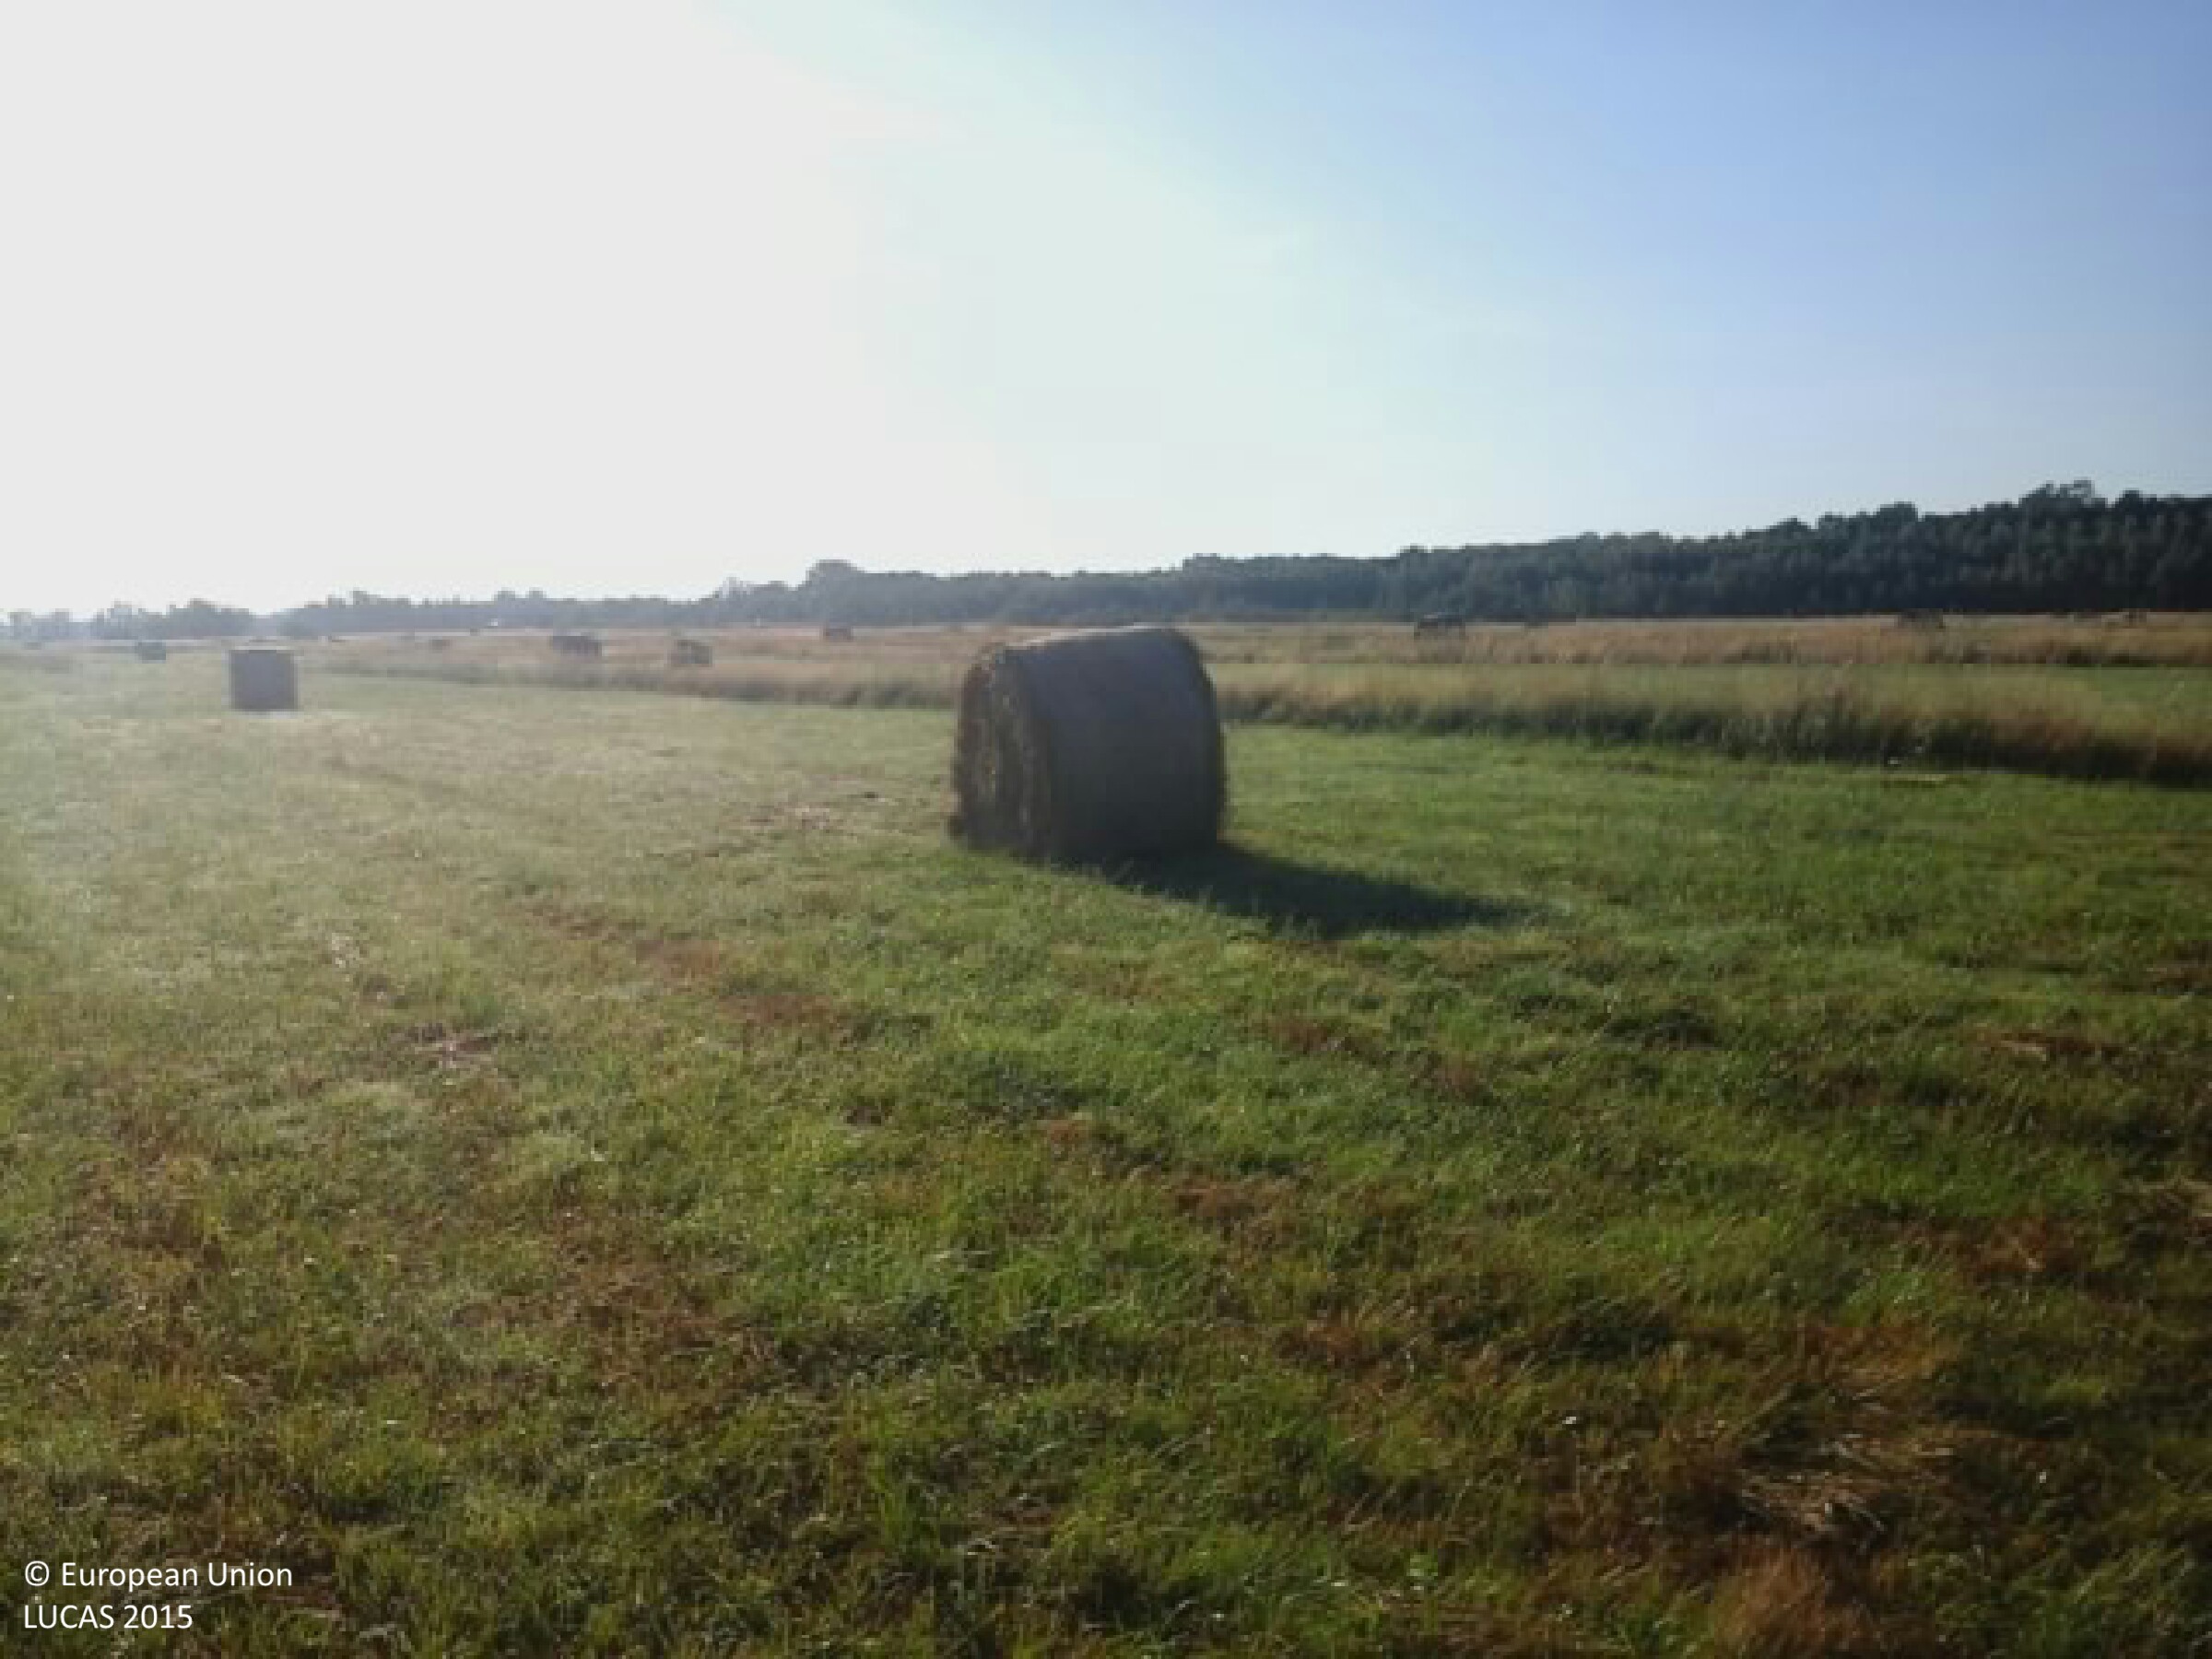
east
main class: Grassland
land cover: Grassland without tree/shrub cover
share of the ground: > 75 %
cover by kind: herbaceous plants 100 %
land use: Agriculture (excluding fallow land and kitchen gardens)
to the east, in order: Grassland without tree/shrub cover
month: August
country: HU
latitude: 46.6901
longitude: 17.4192
